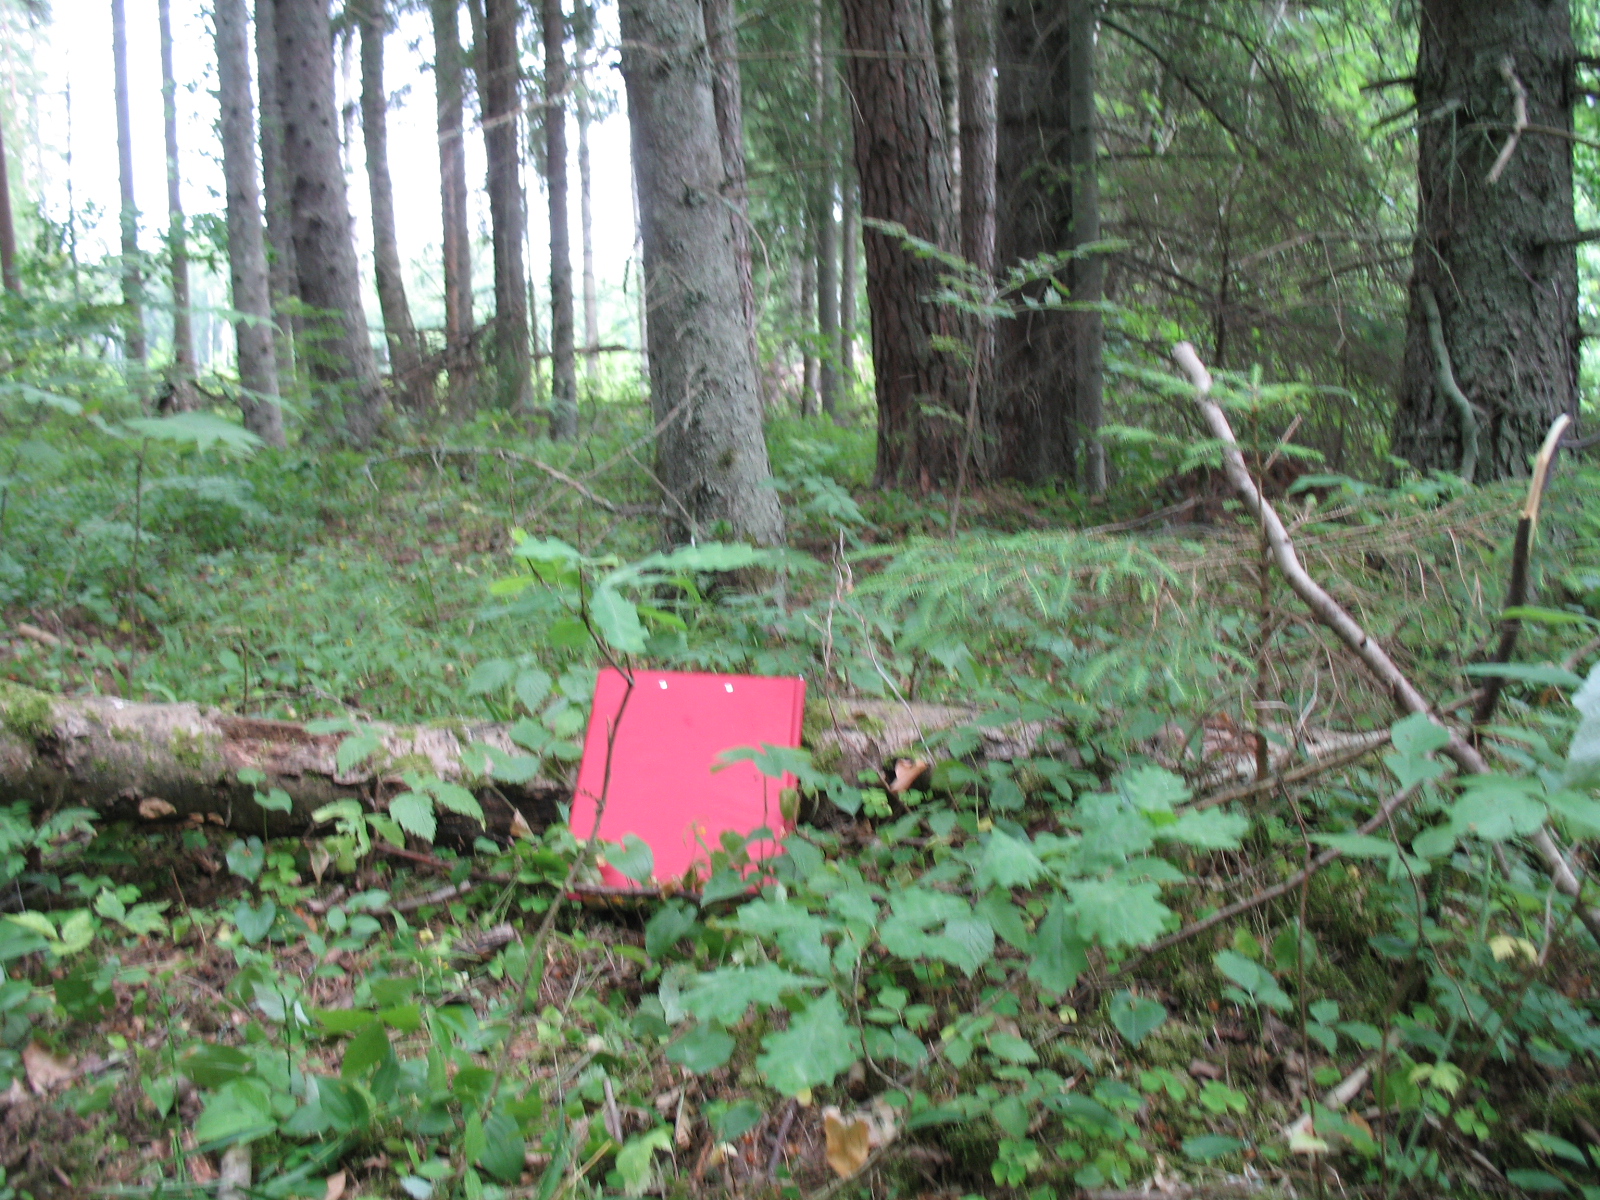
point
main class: Woodland
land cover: Other coniferous woodland
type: hemiboreal forest and nemoral coniferous forest and mixed broadleaved-coniferous forest
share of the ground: > 75 %
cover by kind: coniferous forest trees 80 %, broadleaved forest trees 10 %, herbaceous plants 5 %, lichens and mosses 5 %
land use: Forestry
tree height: > 5 m
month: July
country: LV
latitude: 56.7495
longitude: 23.8334
